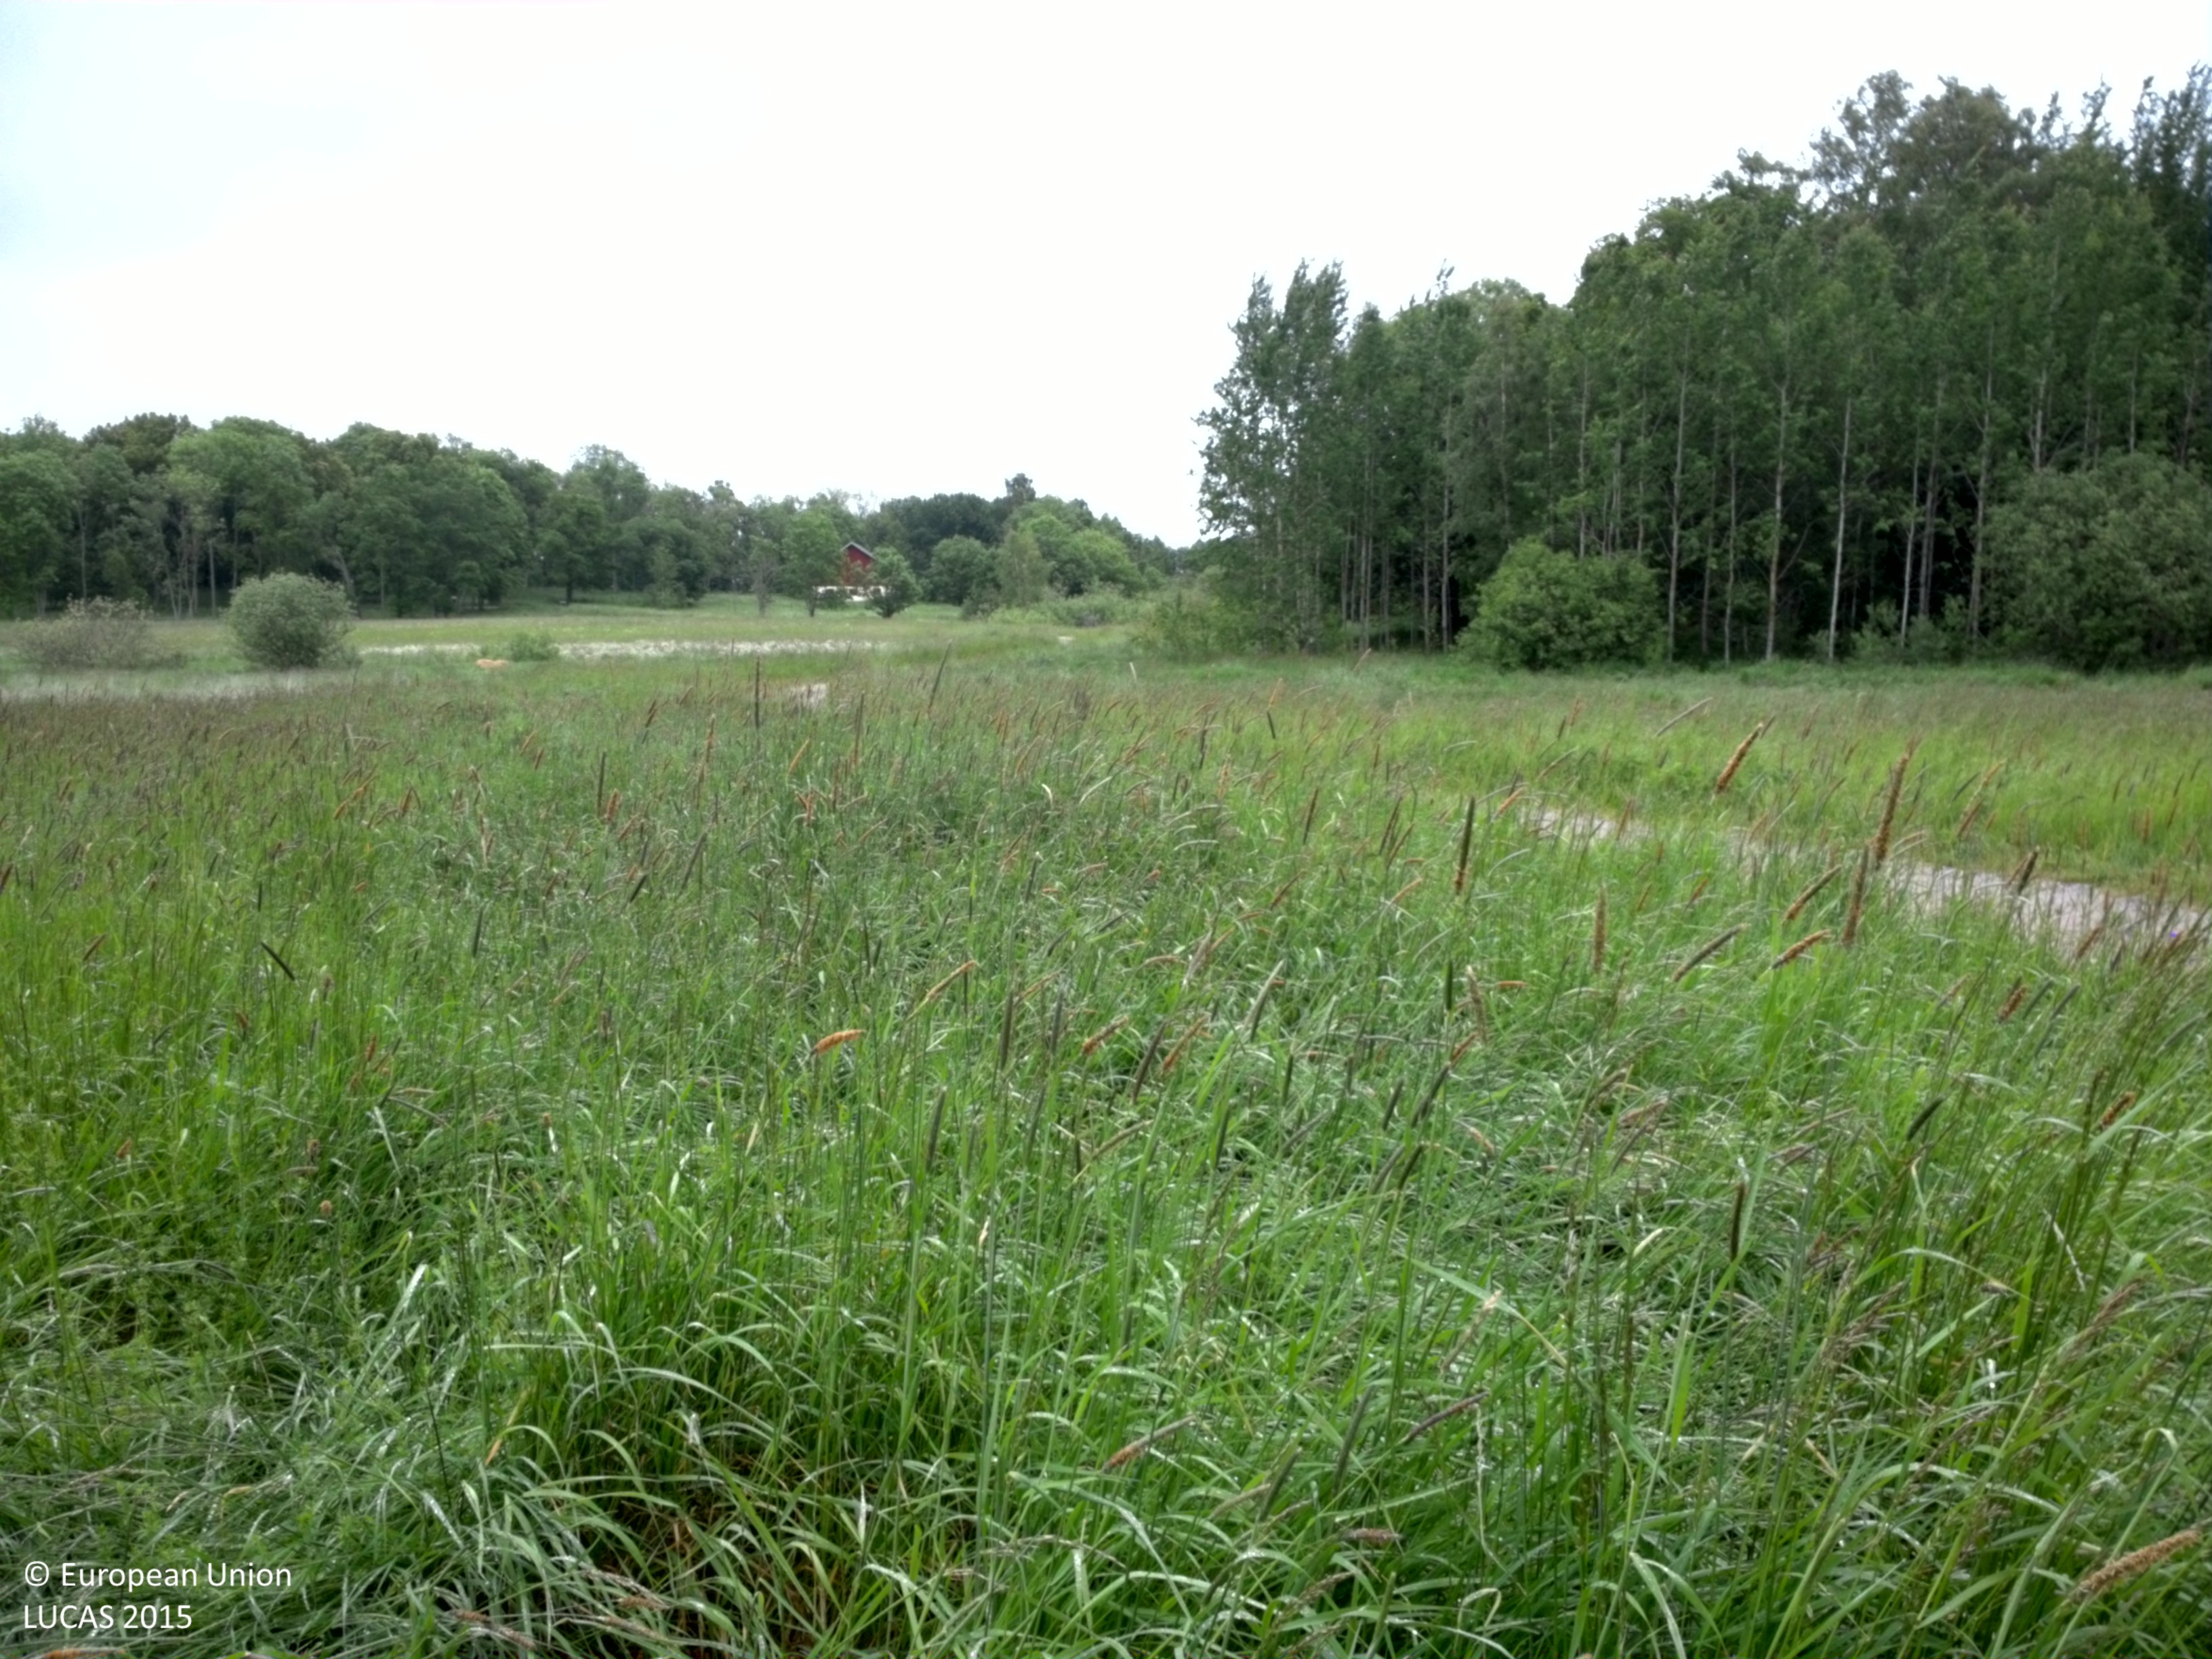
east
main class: Cropland
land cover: Other leguminous and mixtures for fodder
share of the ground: > 75 %
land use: Agriculture (excluding fallow land and kitchen gardens)
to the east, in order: Other leguminous and mixtures for fodder; Ditches and canals; Paved roads, cycling and walking lanes; Ditches and canals; Other leguminous and mixtures for fodder; Ditches and canals; Paved roads, cycling and walking lanes; Ditches and canals; Grassland without tree/shrub cover; Single bushes/trees; Spontaneously vegetated surfaces; Broadleaved woodland
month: June
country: SE
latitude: 59.7306
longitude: 18.6973
